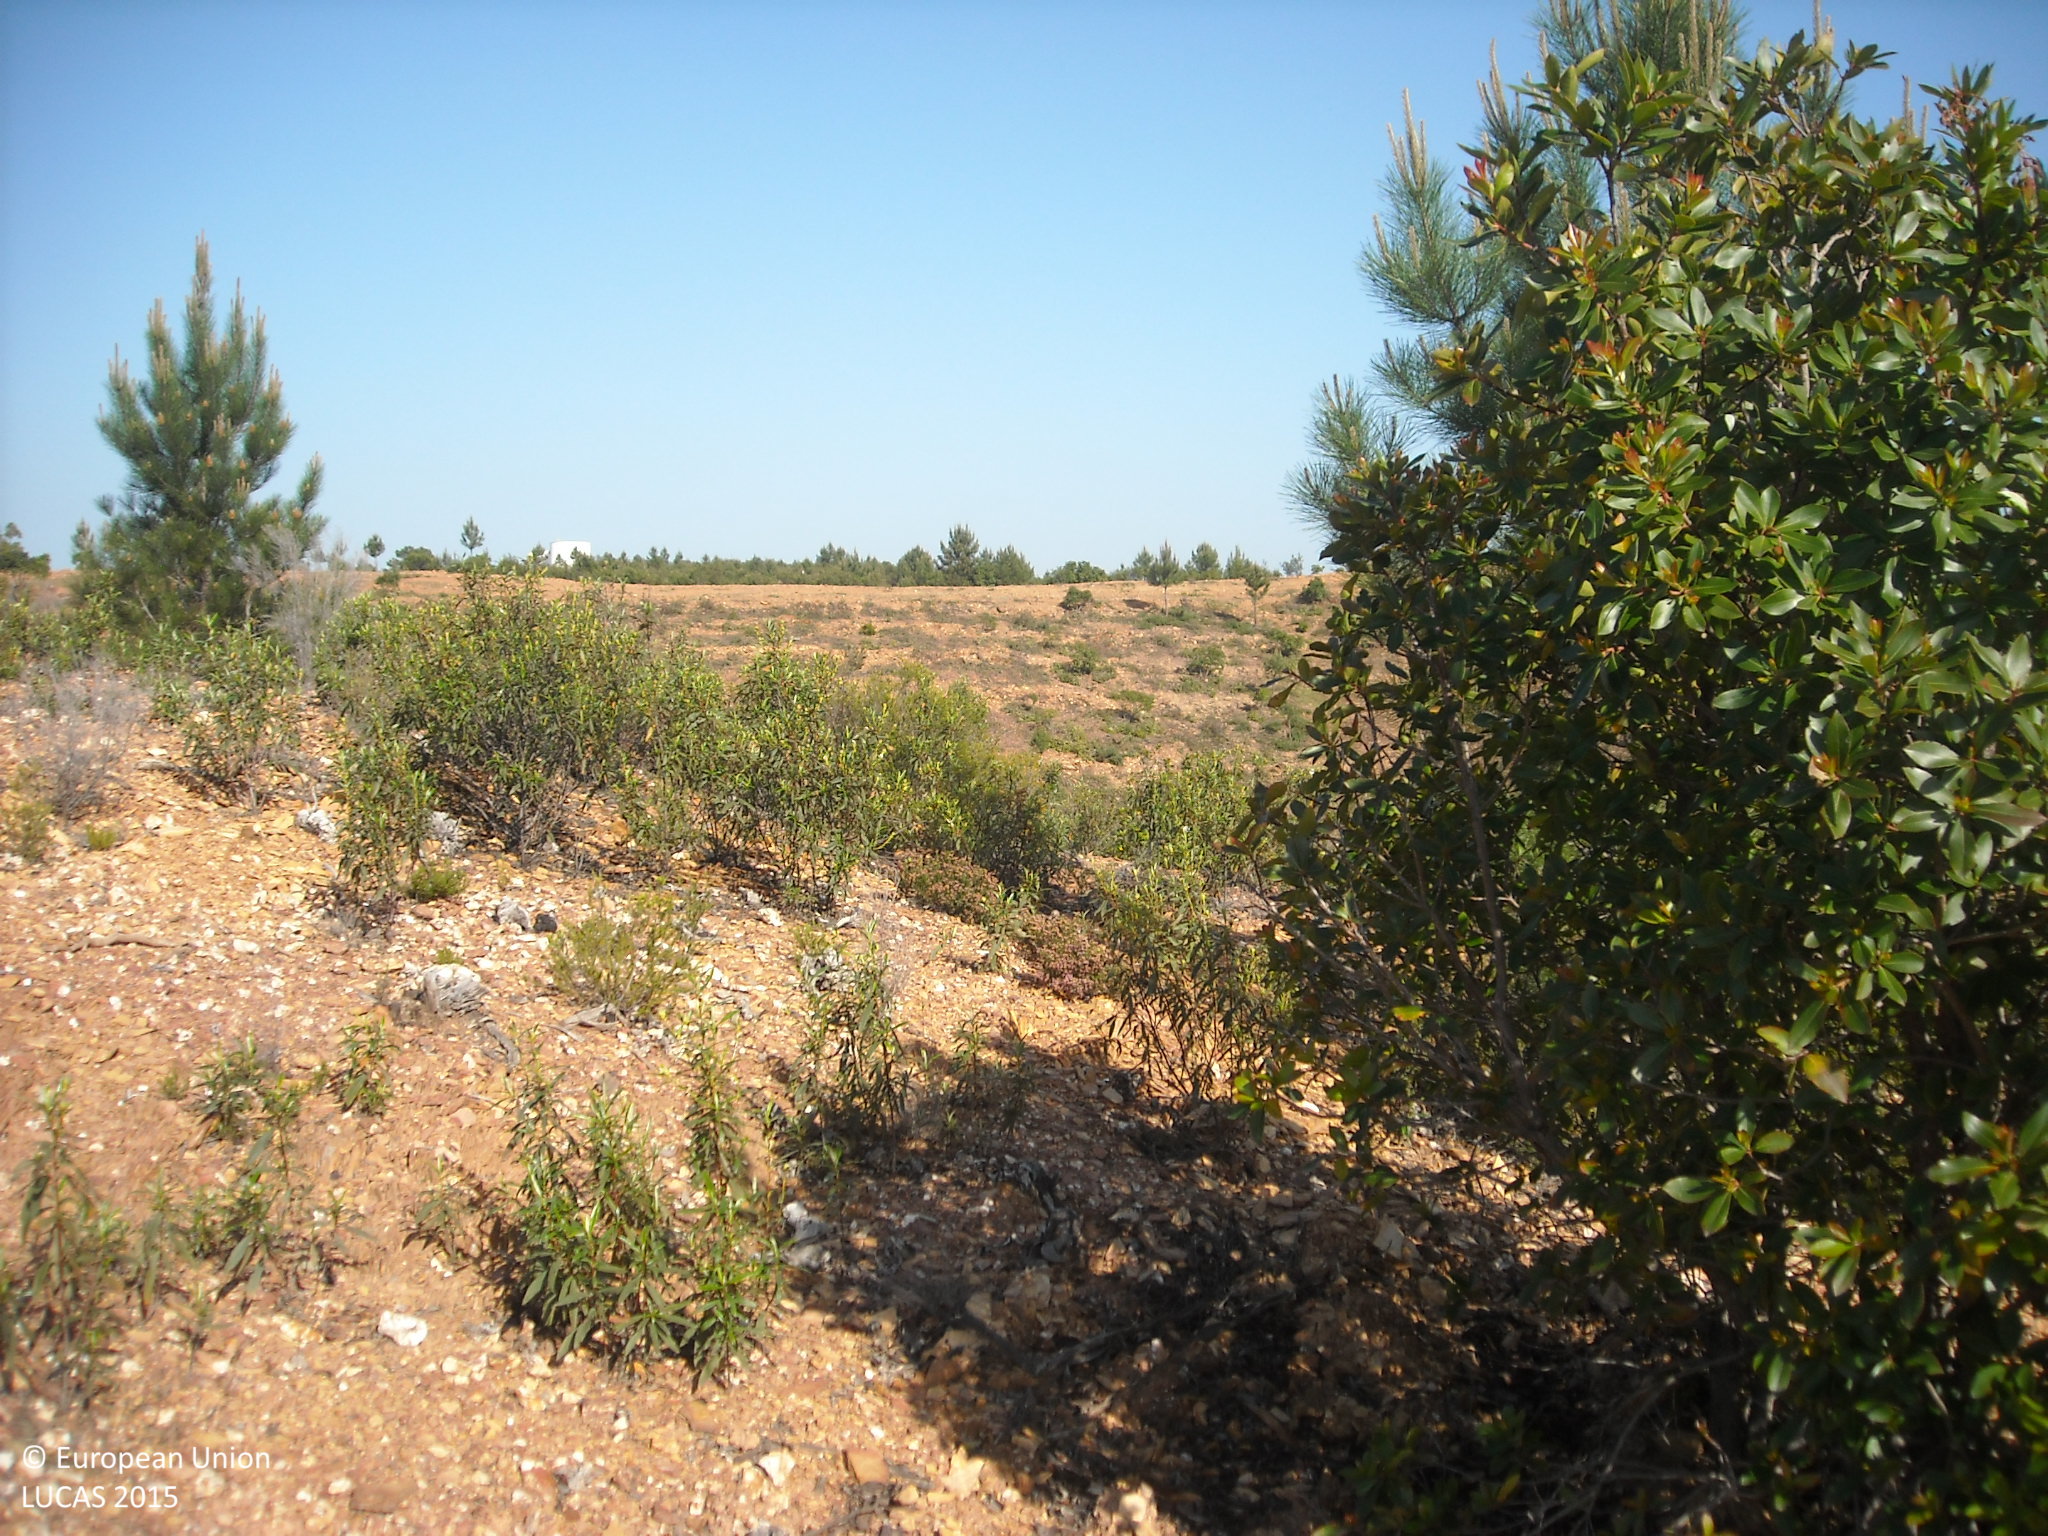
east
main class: Shrubland
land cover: Shrubland without tree cover
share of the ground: 50 - 75 %
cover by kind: shrubs 50 %, herbaceous plants 50 %
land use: Semi-natural and natural areas not in use
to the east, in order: Shrubland without tree cover; Tracks; Shrubland without tree cover; Tracks
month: April
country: ES
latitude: 37.6320
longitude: -6.4557
